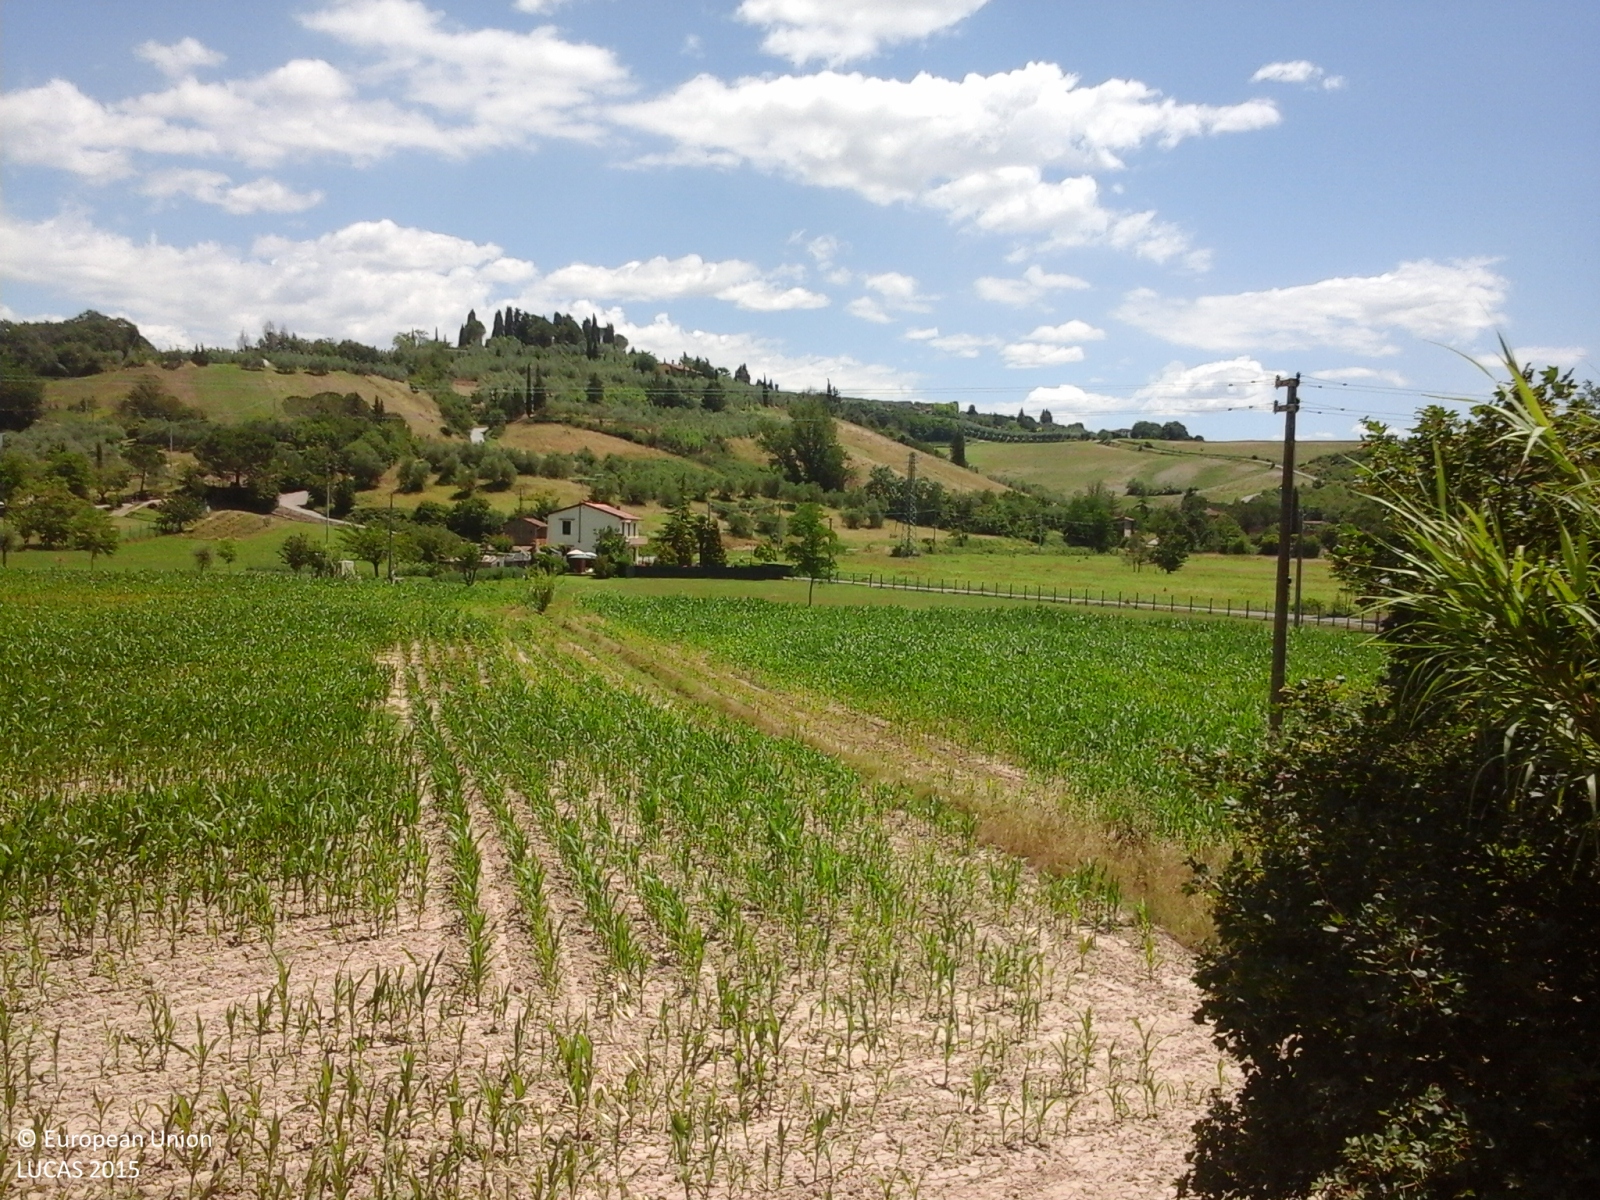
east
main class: Cropland
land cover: Maize
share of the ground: > 75 %
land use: Agriculture (excluding fallow land and kitchen gardens)
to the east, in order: Maize; Ditches and canals; Abandoned hedges; Tomatoes; Grassland without tree/shrub cover; Electric lines; Grassland without tree/shrub cover; Fences; Ditches and canals; Paved roads, cycling and walking lanes; Abandoned hedges; Grassland without tree/shrub cover
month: June
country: IT
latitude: 43.6062
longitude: 10.9761
